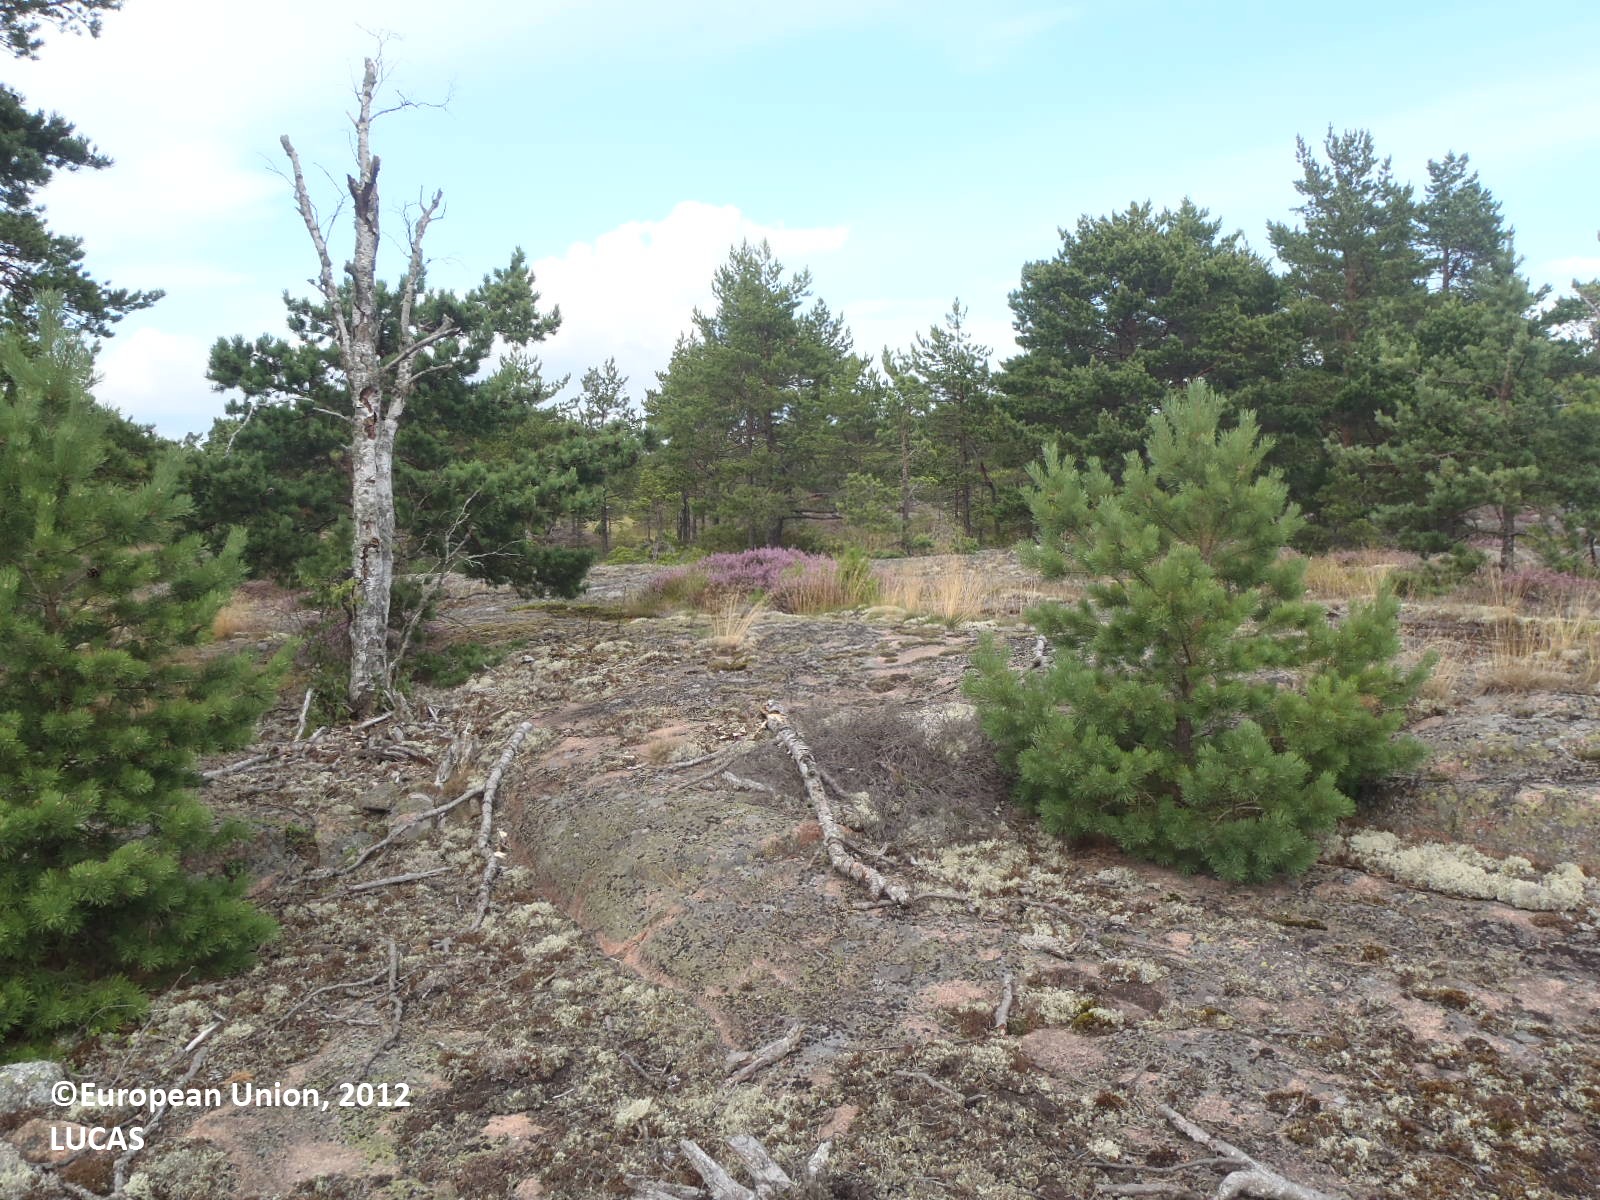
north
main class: Woodland
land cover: Pine dominated coniferous woodland
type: boreal forest
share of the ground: 10 - 25 %
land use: Semi-natural and natural areas not in use
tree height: > 5 m
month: August
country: FI
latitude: 60.2321
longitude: 20.3928
